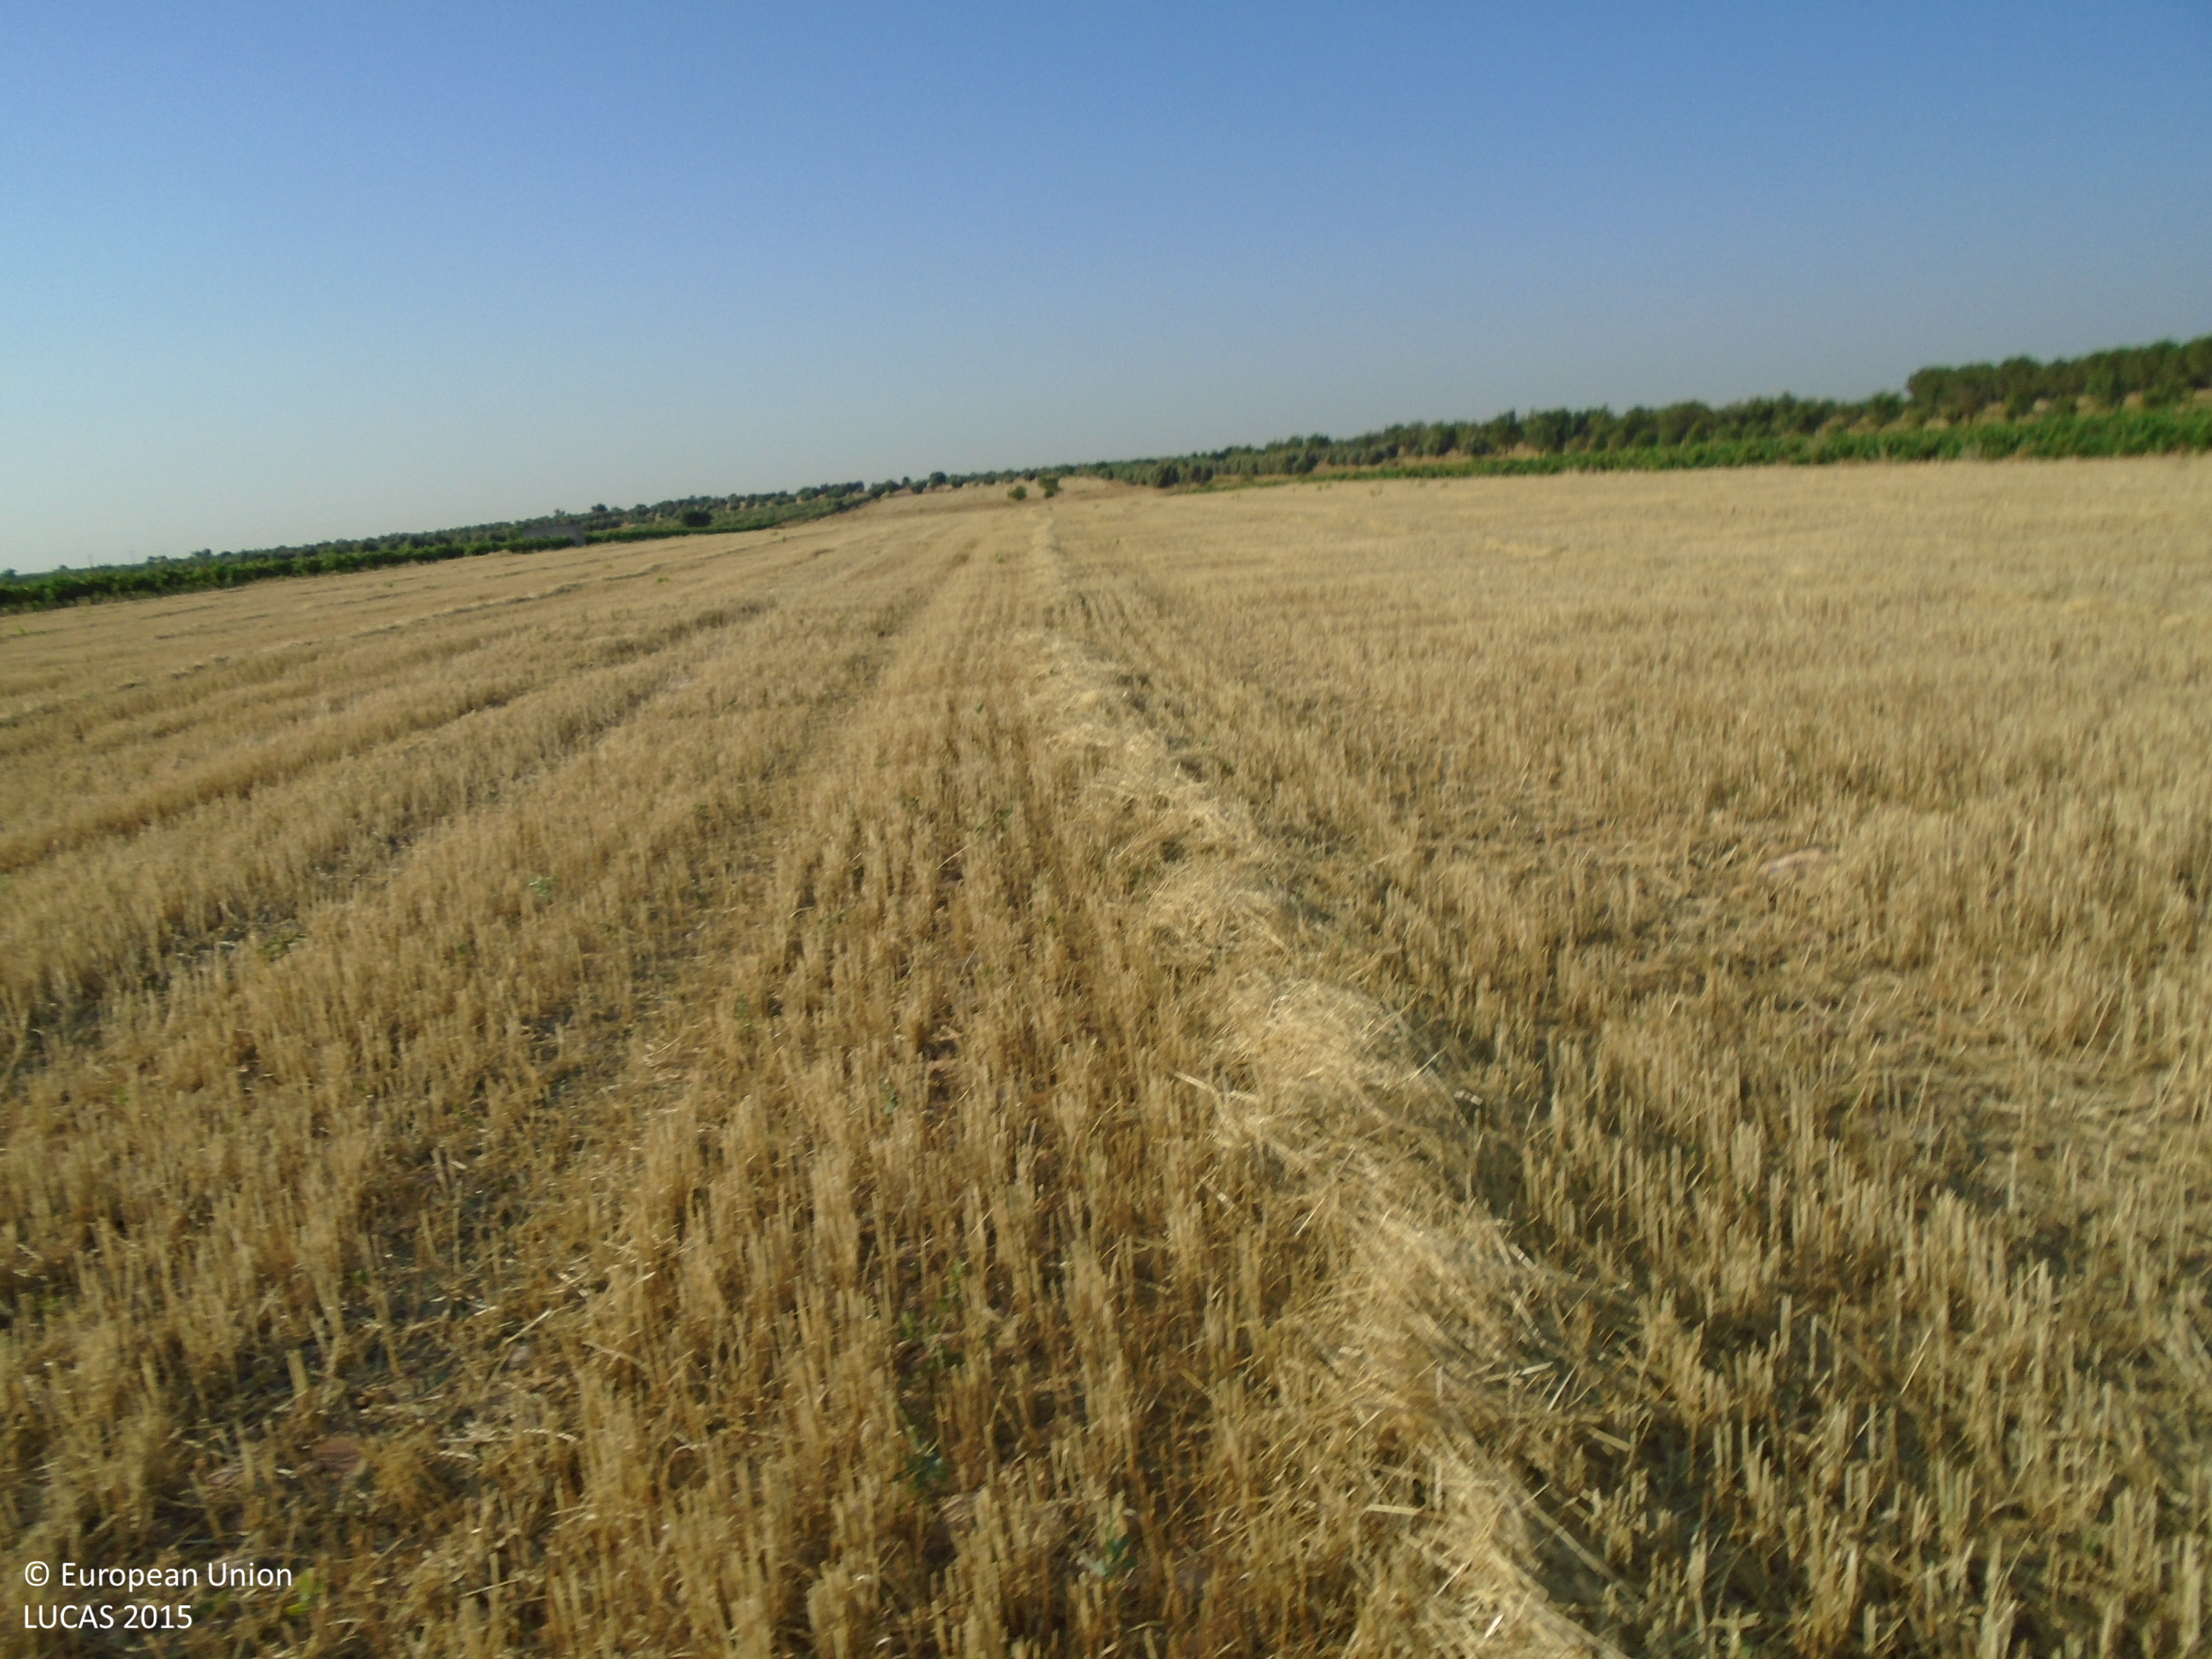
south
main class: Cropland
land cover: Barley
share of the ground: > 75 %
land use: Agriculture (excluding fallow land and kitchen gardens)
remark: Harvested field
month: June
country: ES
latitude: 39.1694
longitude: -3.5959
